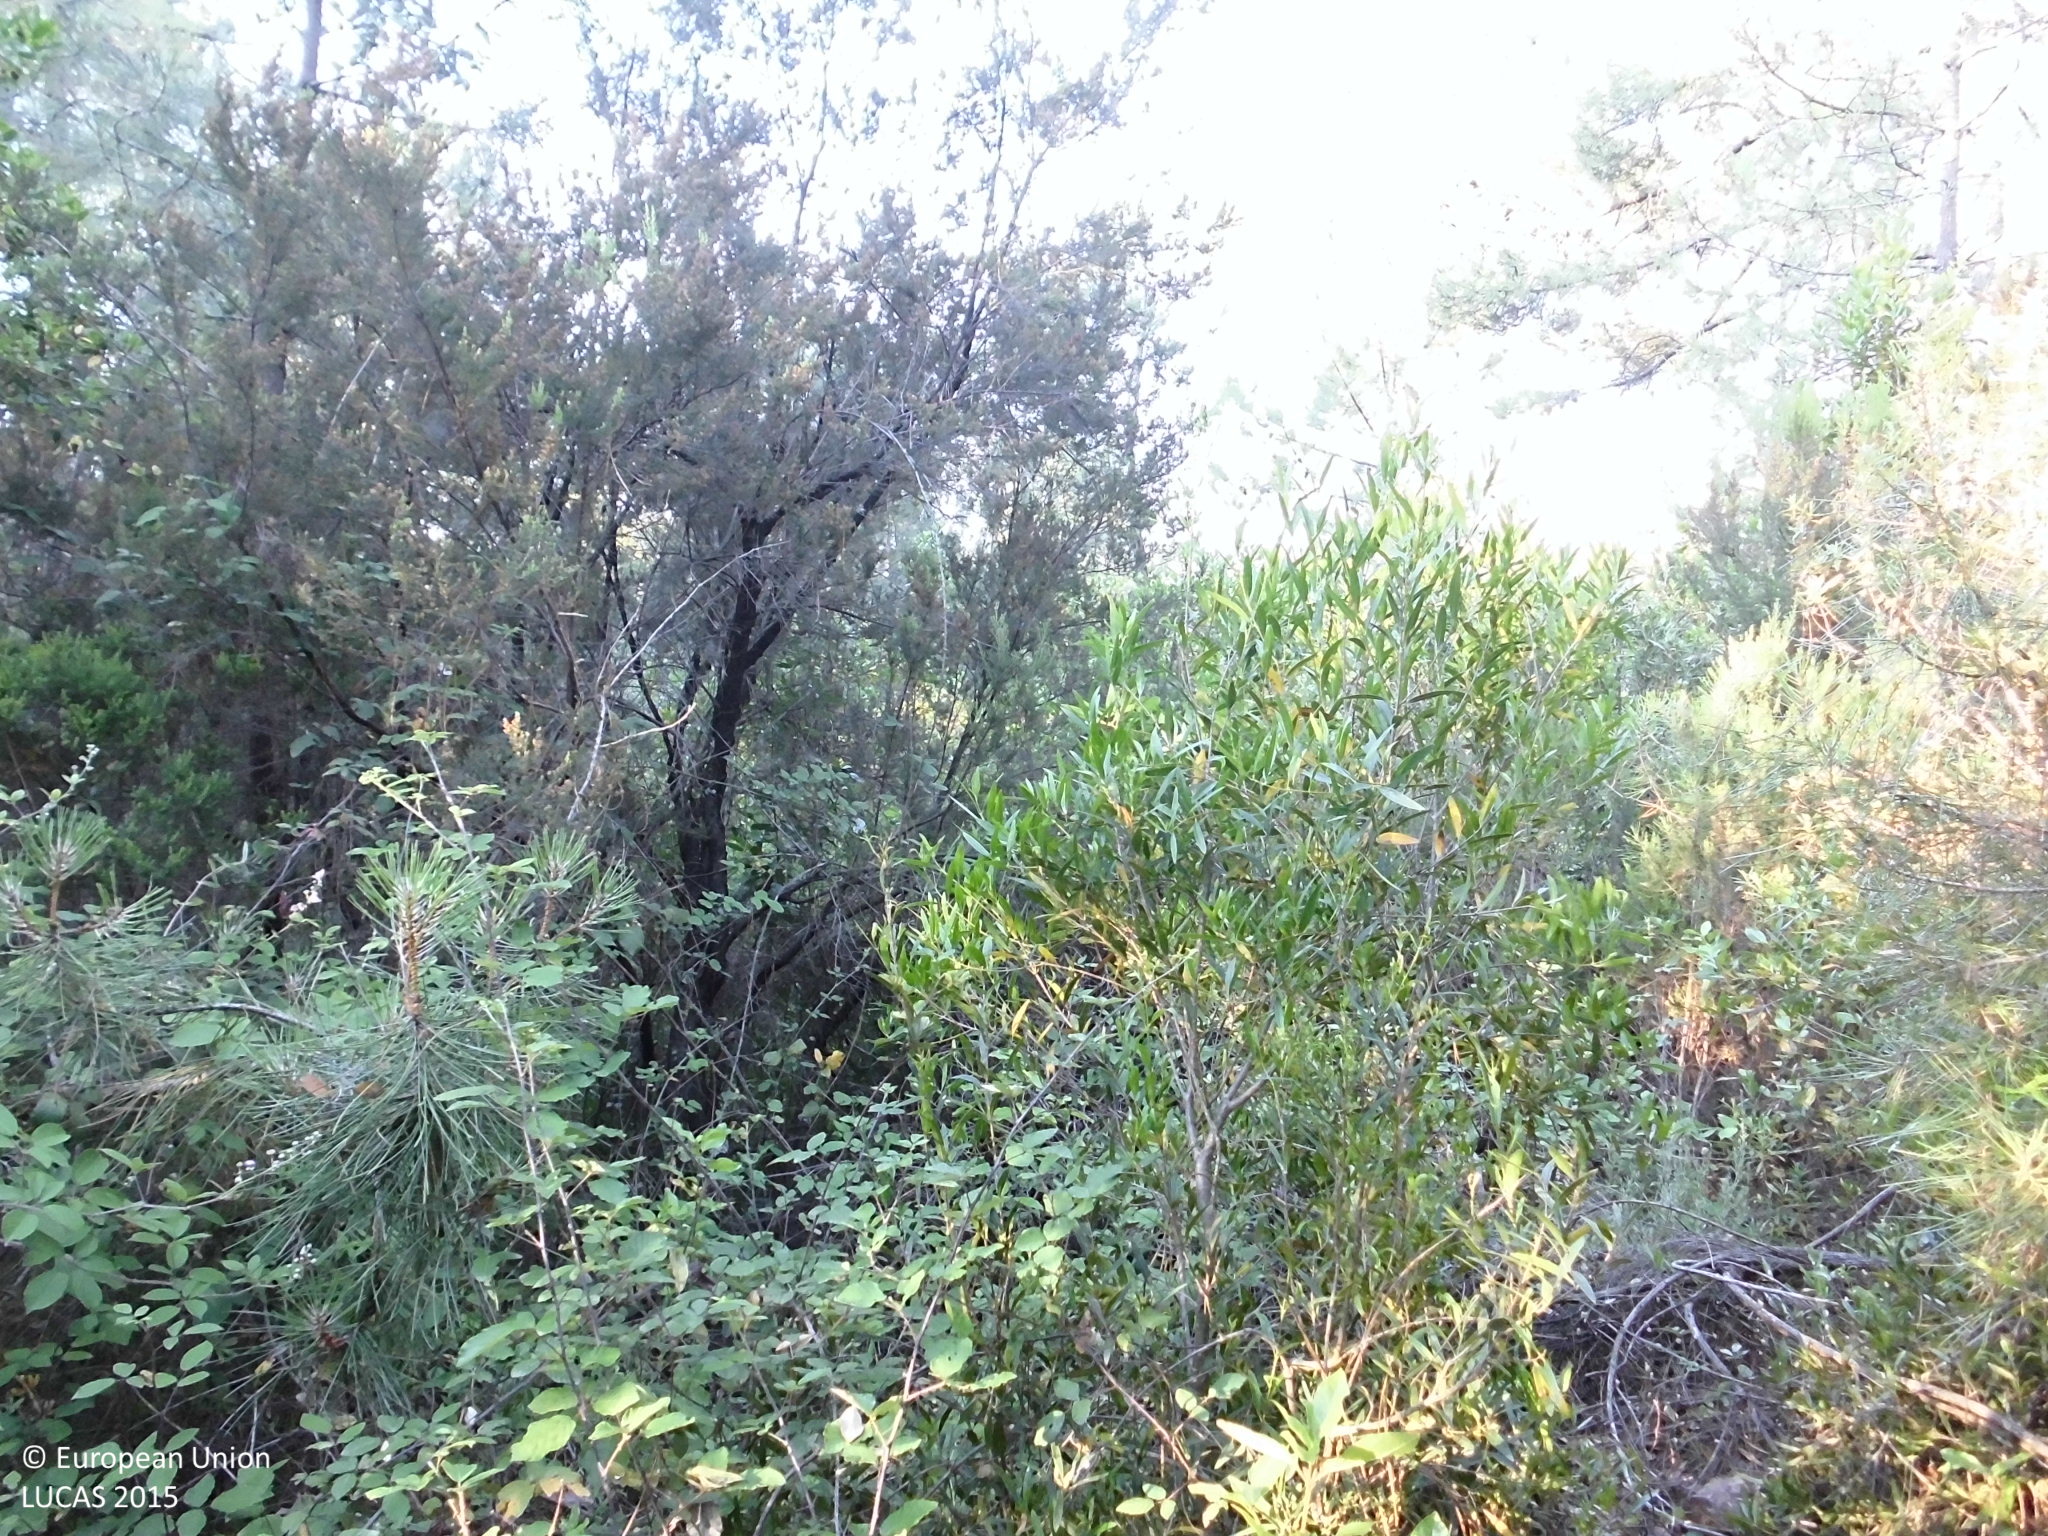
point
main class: Woodland
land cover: Pine dominated mixed woodland
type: thermophilous deciduous forest
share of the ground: > 75 %
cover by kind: coniferous forest trees 50 %, broadleaved forest trees 25 %, shrubs 20 %, herbaceous plants 5 %
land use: Forestry
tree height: > 5 m
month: June
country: ES
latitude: 40.1169
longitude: -5.4668
